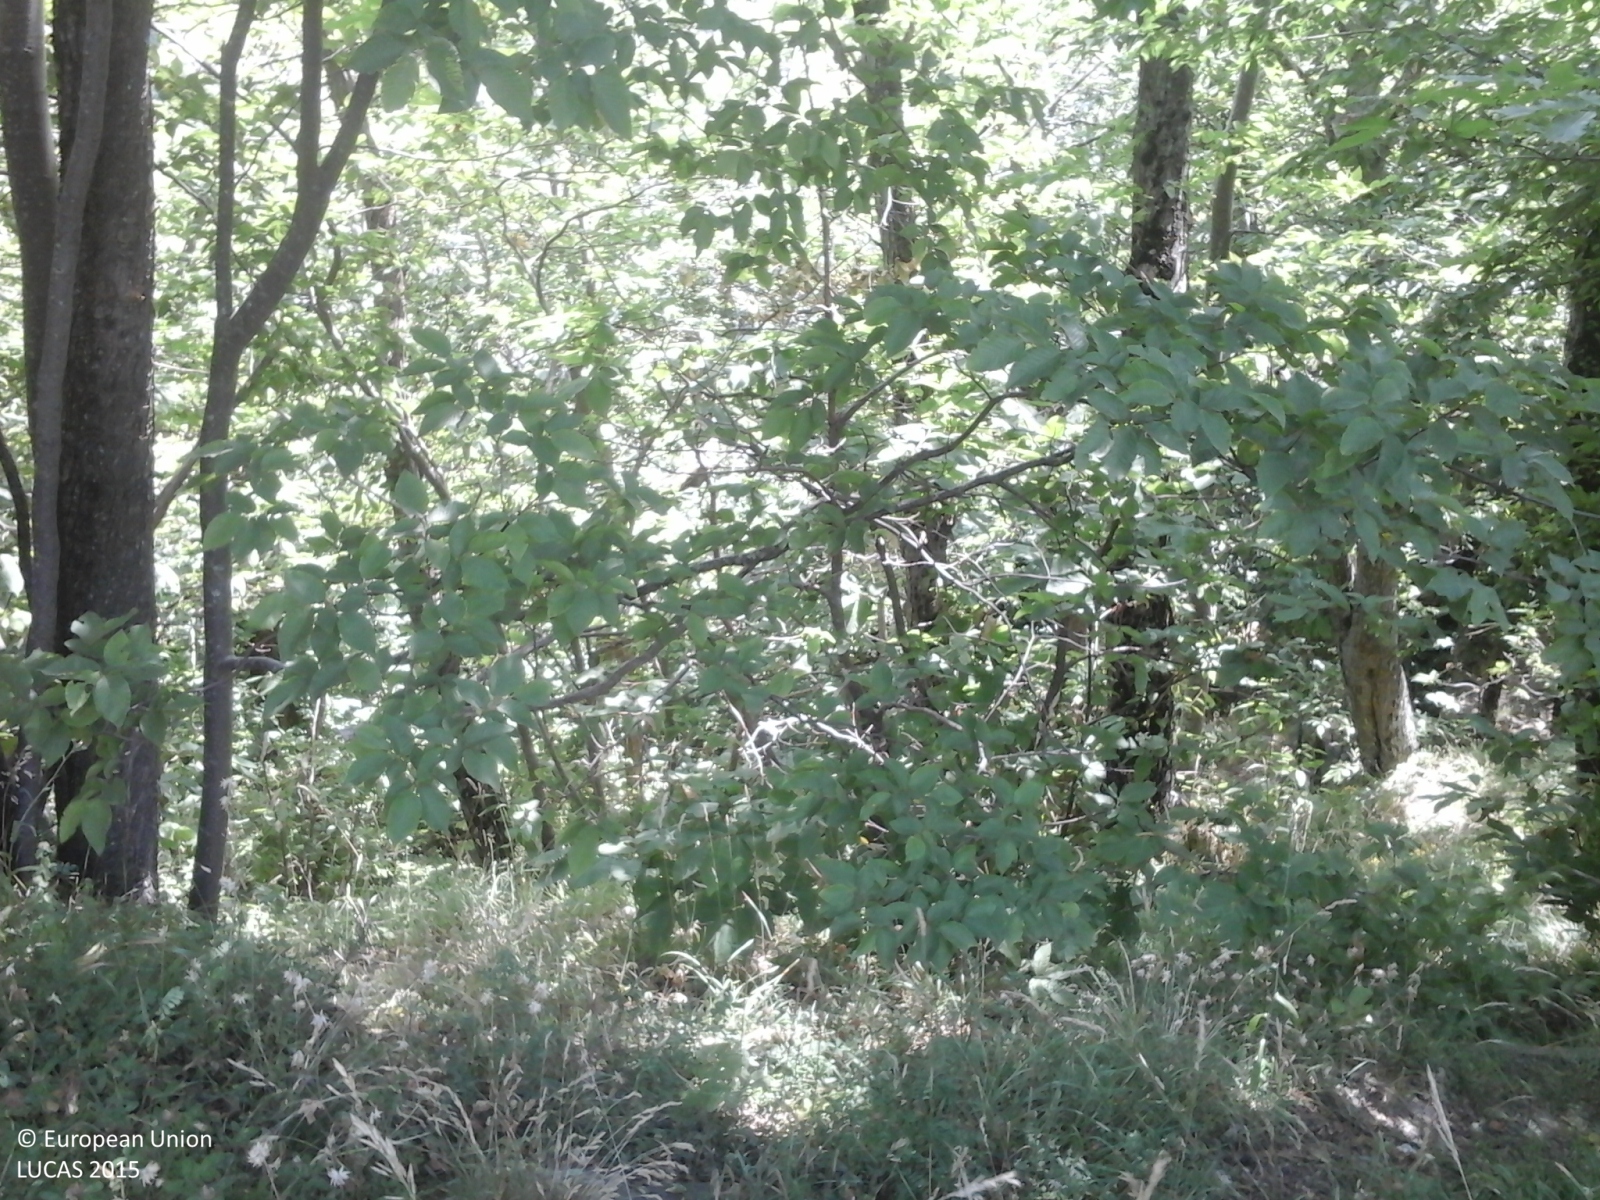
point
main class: Woodland
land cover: Broadleaved woodland
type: thermophilous deciduous forest
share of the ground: > 75 %
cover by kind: broadleaved forest trees 100 %
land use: Forestry
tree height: > 5 m
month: July
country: IT
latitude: 44.3681
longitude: 10.3130
